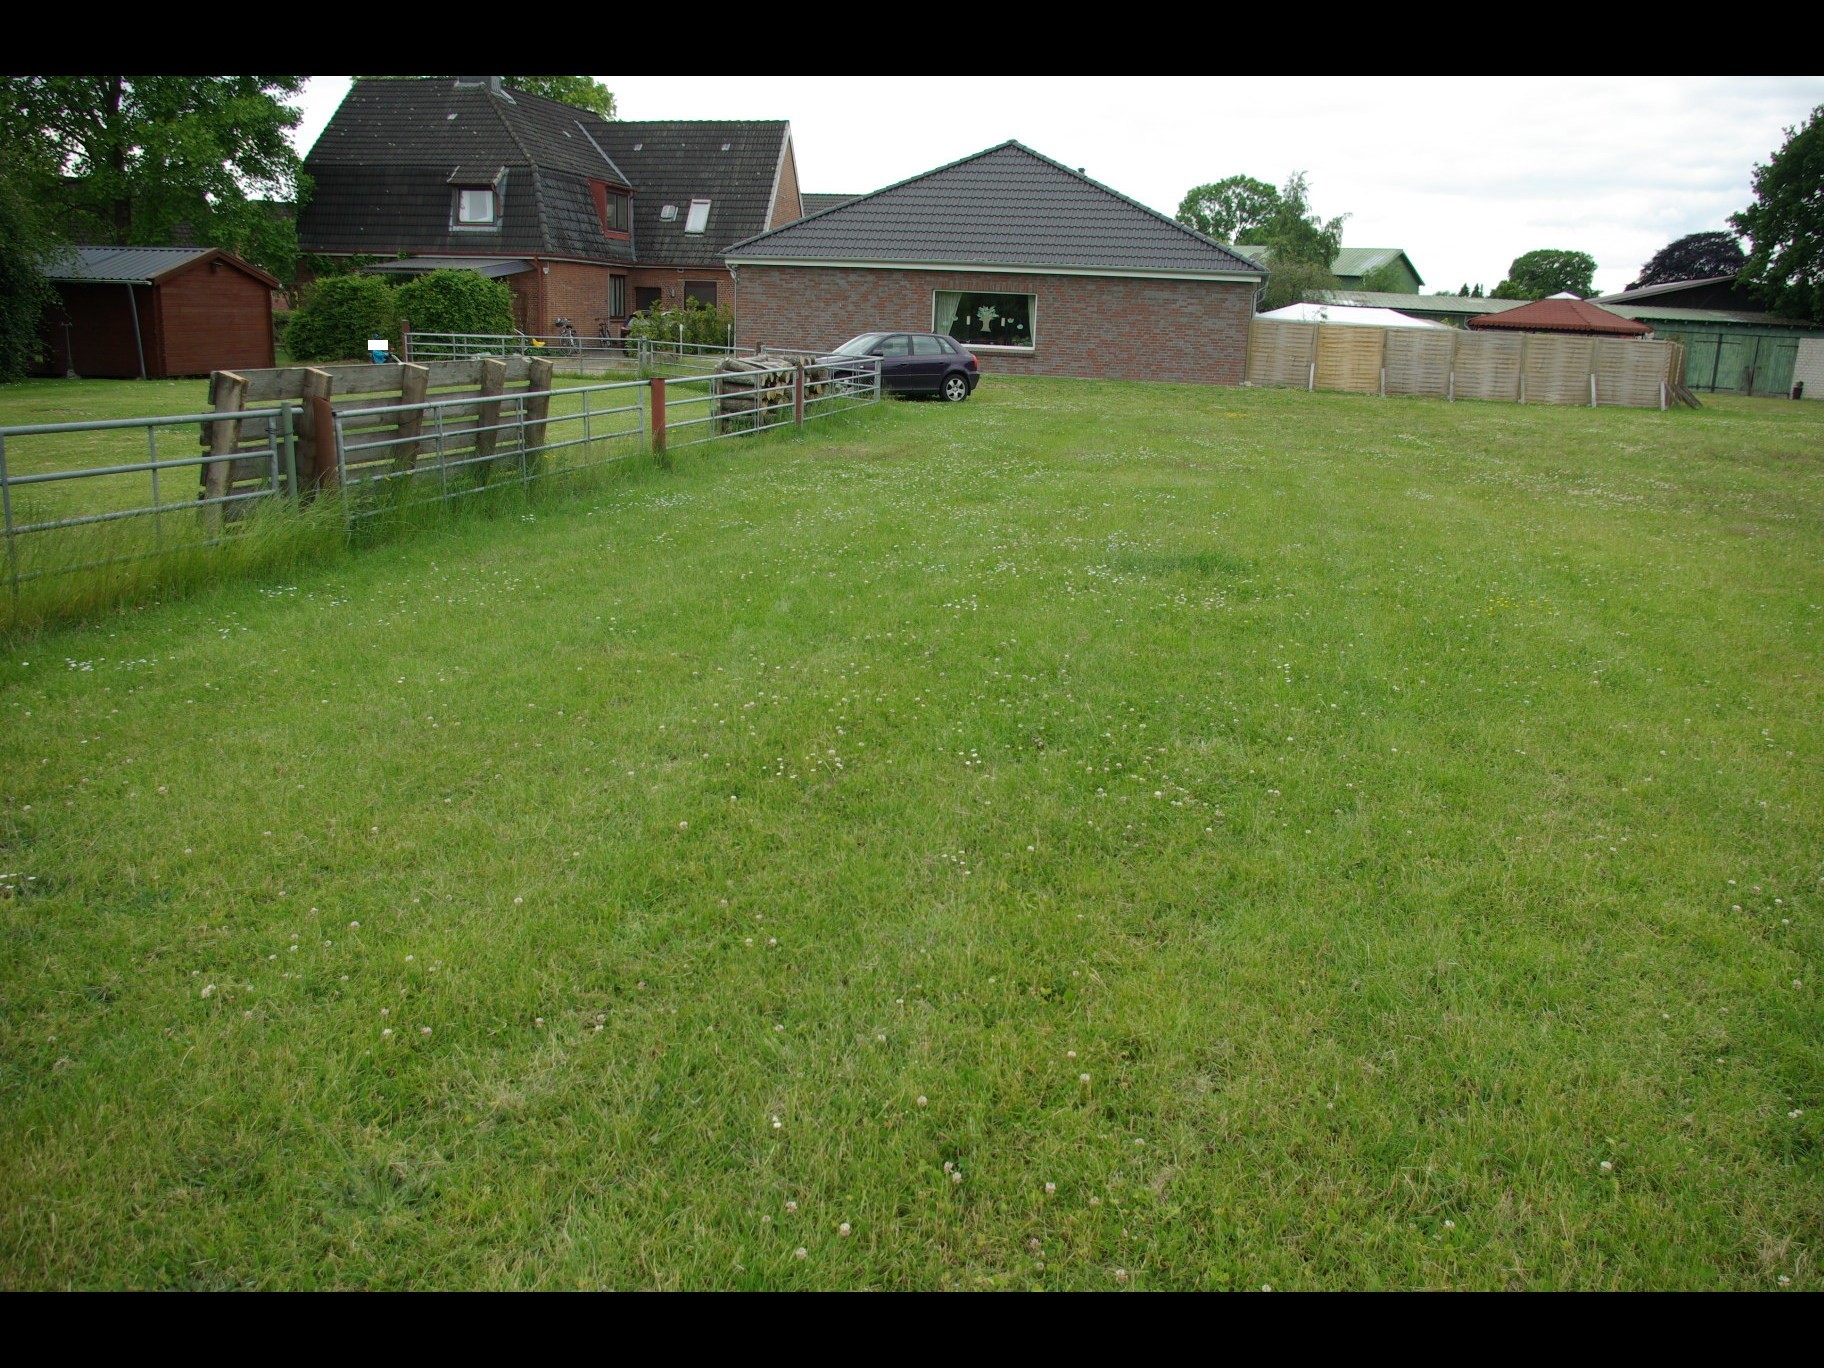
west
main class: Grassland
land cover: Grassland without tree/shrub cover
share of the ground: > 75 %
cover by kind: herbaceous plants 100 %
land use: Agriculture (excluding fallow land and kitchen gardens)
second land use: Amenities, museums, leisure
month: June
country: DE
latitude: 54.1387
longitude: 9.8929
